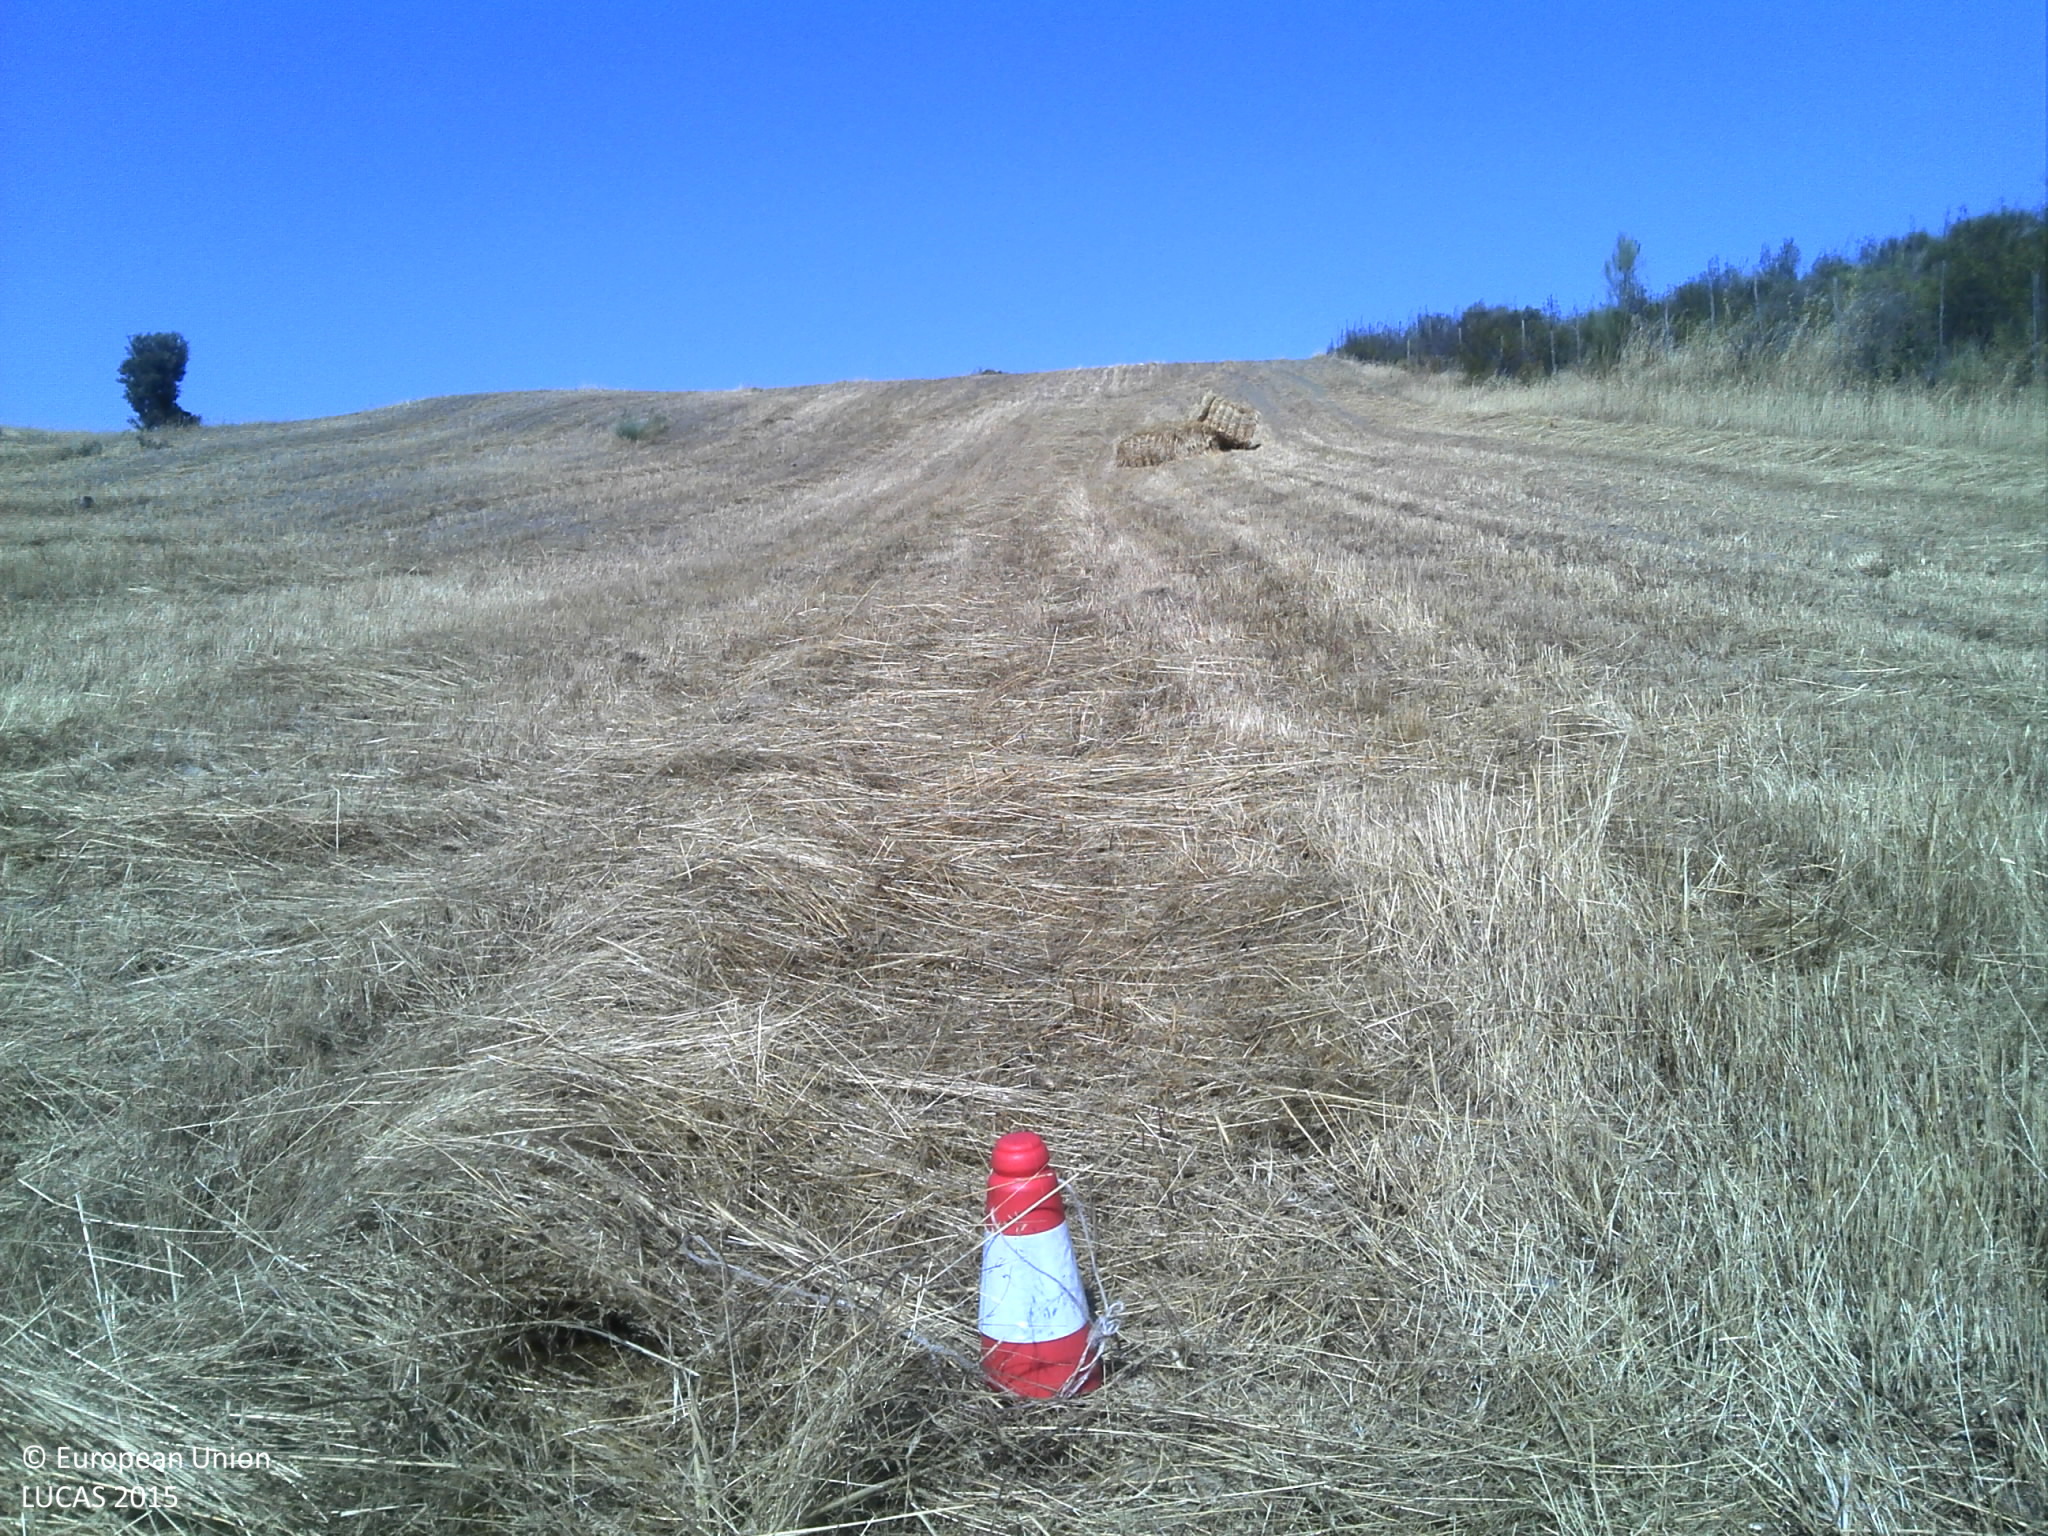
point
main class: Cropland
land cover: Temporary grasslands
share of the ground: 25 - 50 %
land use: Agriculture (excluding fallow land and kitchen gardens)
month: June
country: PT
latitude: 39.9970
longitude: -7.1596
